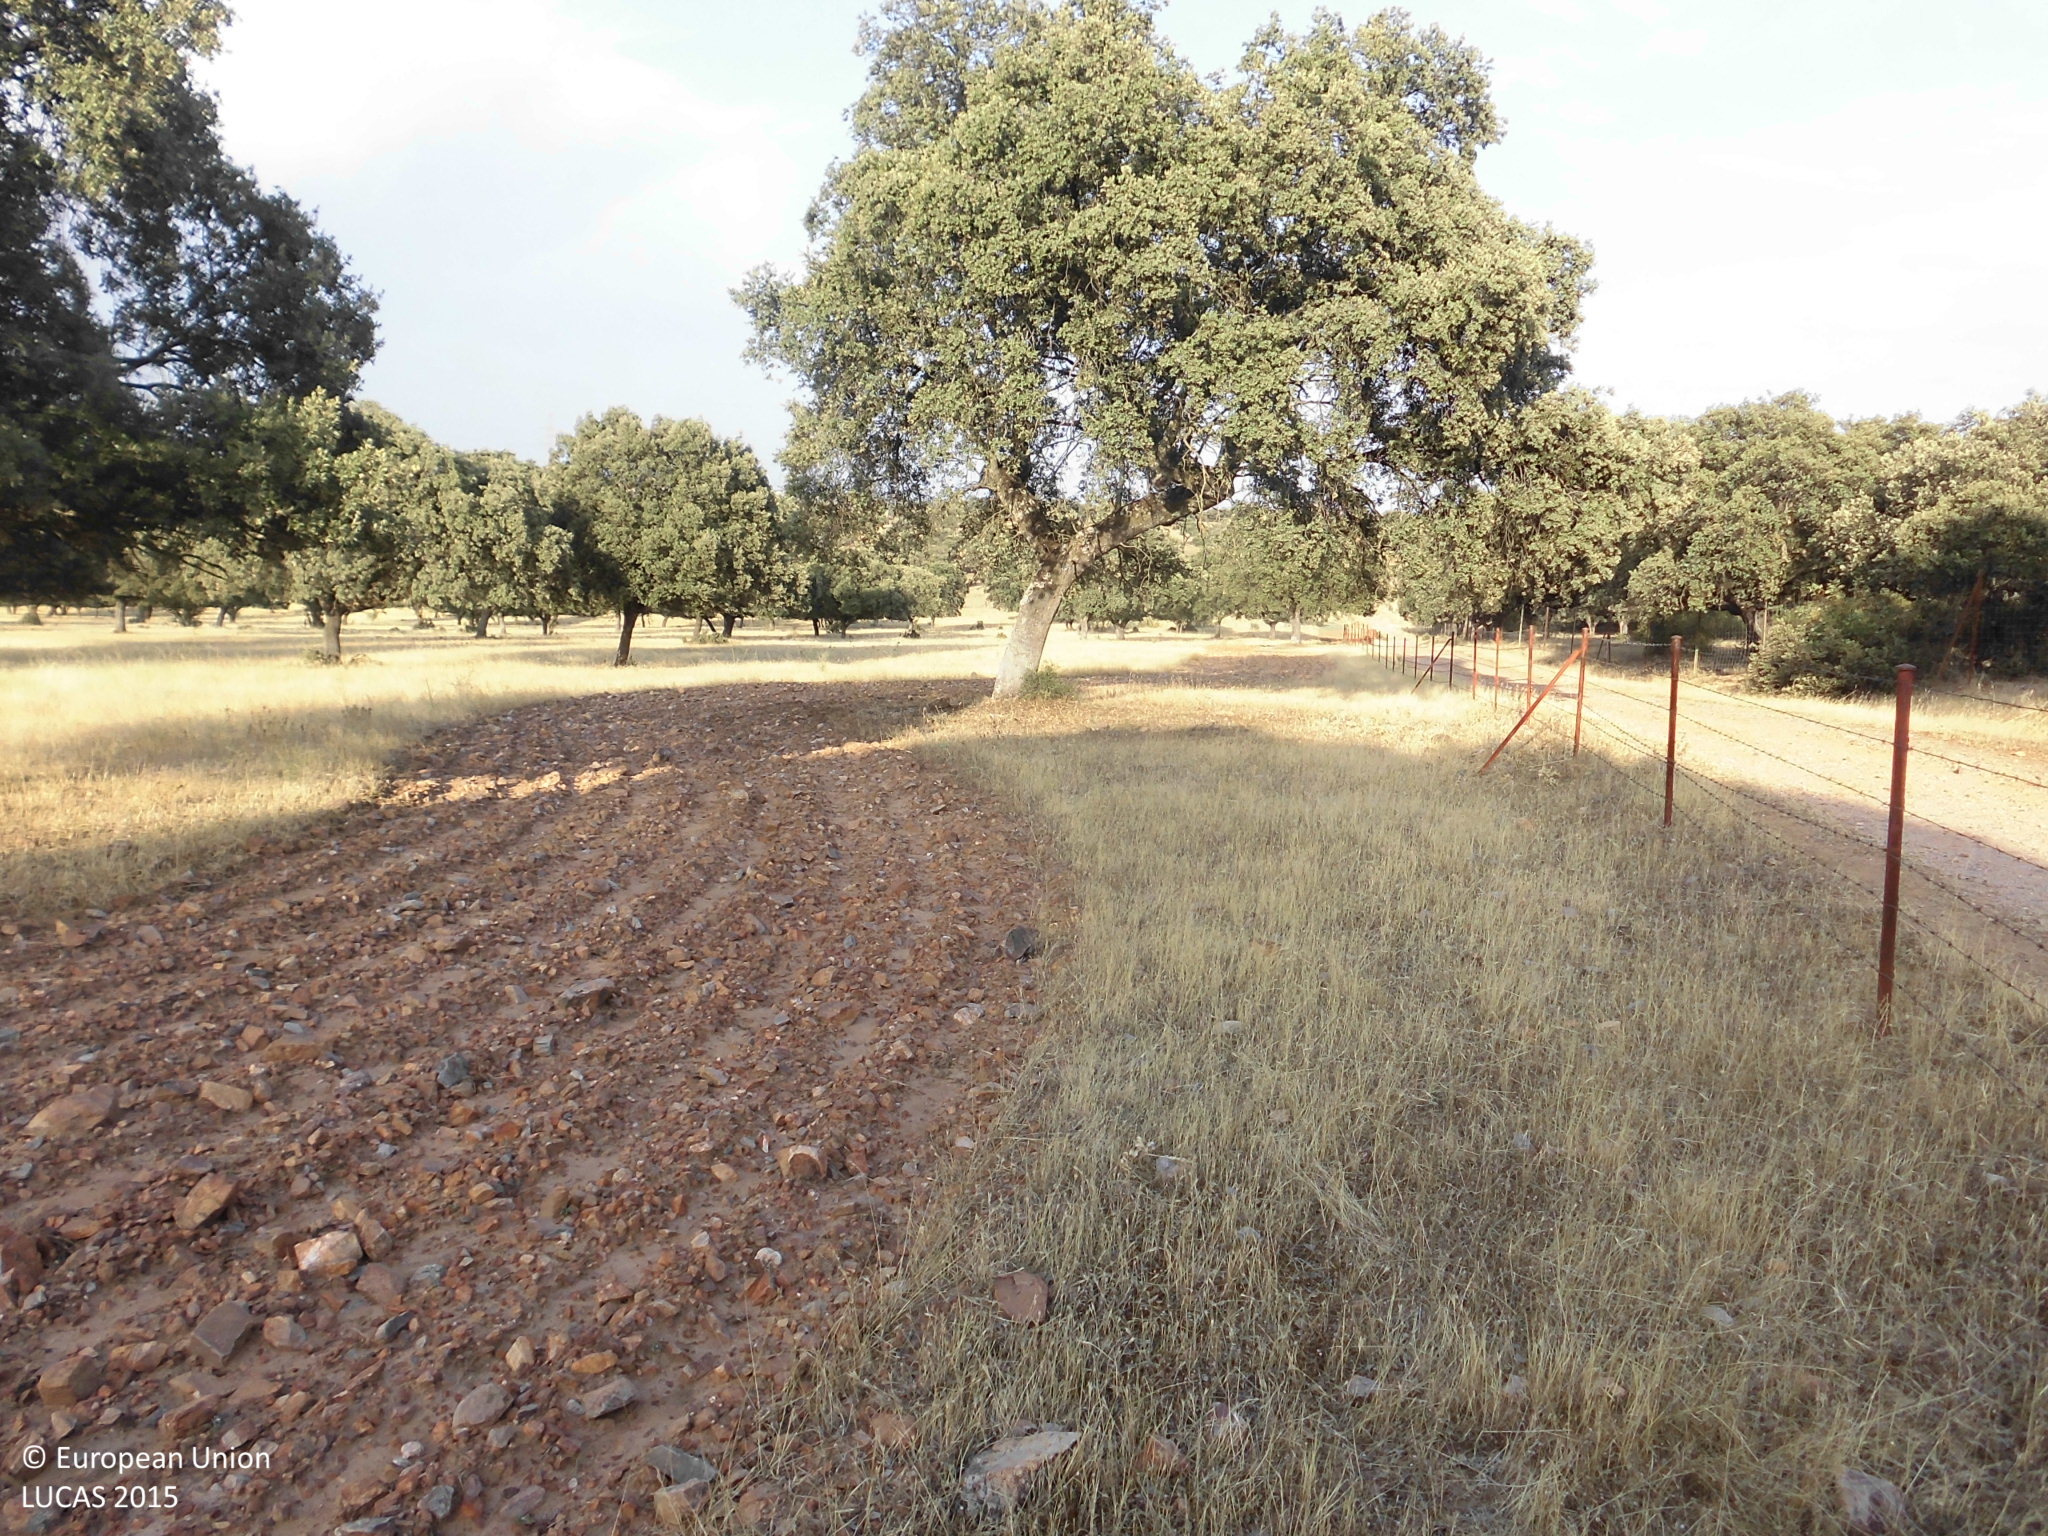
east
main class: Woodland
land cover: Broadleaved woodland
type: broadleaved evergreen forest
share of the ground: 10 - 25 %
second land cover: Grassland without tree/shrub cover
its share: > 75 %
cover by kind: herbaceous plants 65 %, broadleaved forest trees 25 %, unconsolidated bare surface 10 %
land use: Forestry
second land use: Agriculture (excluding fallow land and kitchen gardens)
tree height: > 5 m
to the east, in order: Broadleaved woodland; Grassland without tree/shrub cover; Broadleaved woodland; Other structural elements; Broadleaved woodland
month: July
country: ES
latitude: 39.8111
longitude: -5.6540
